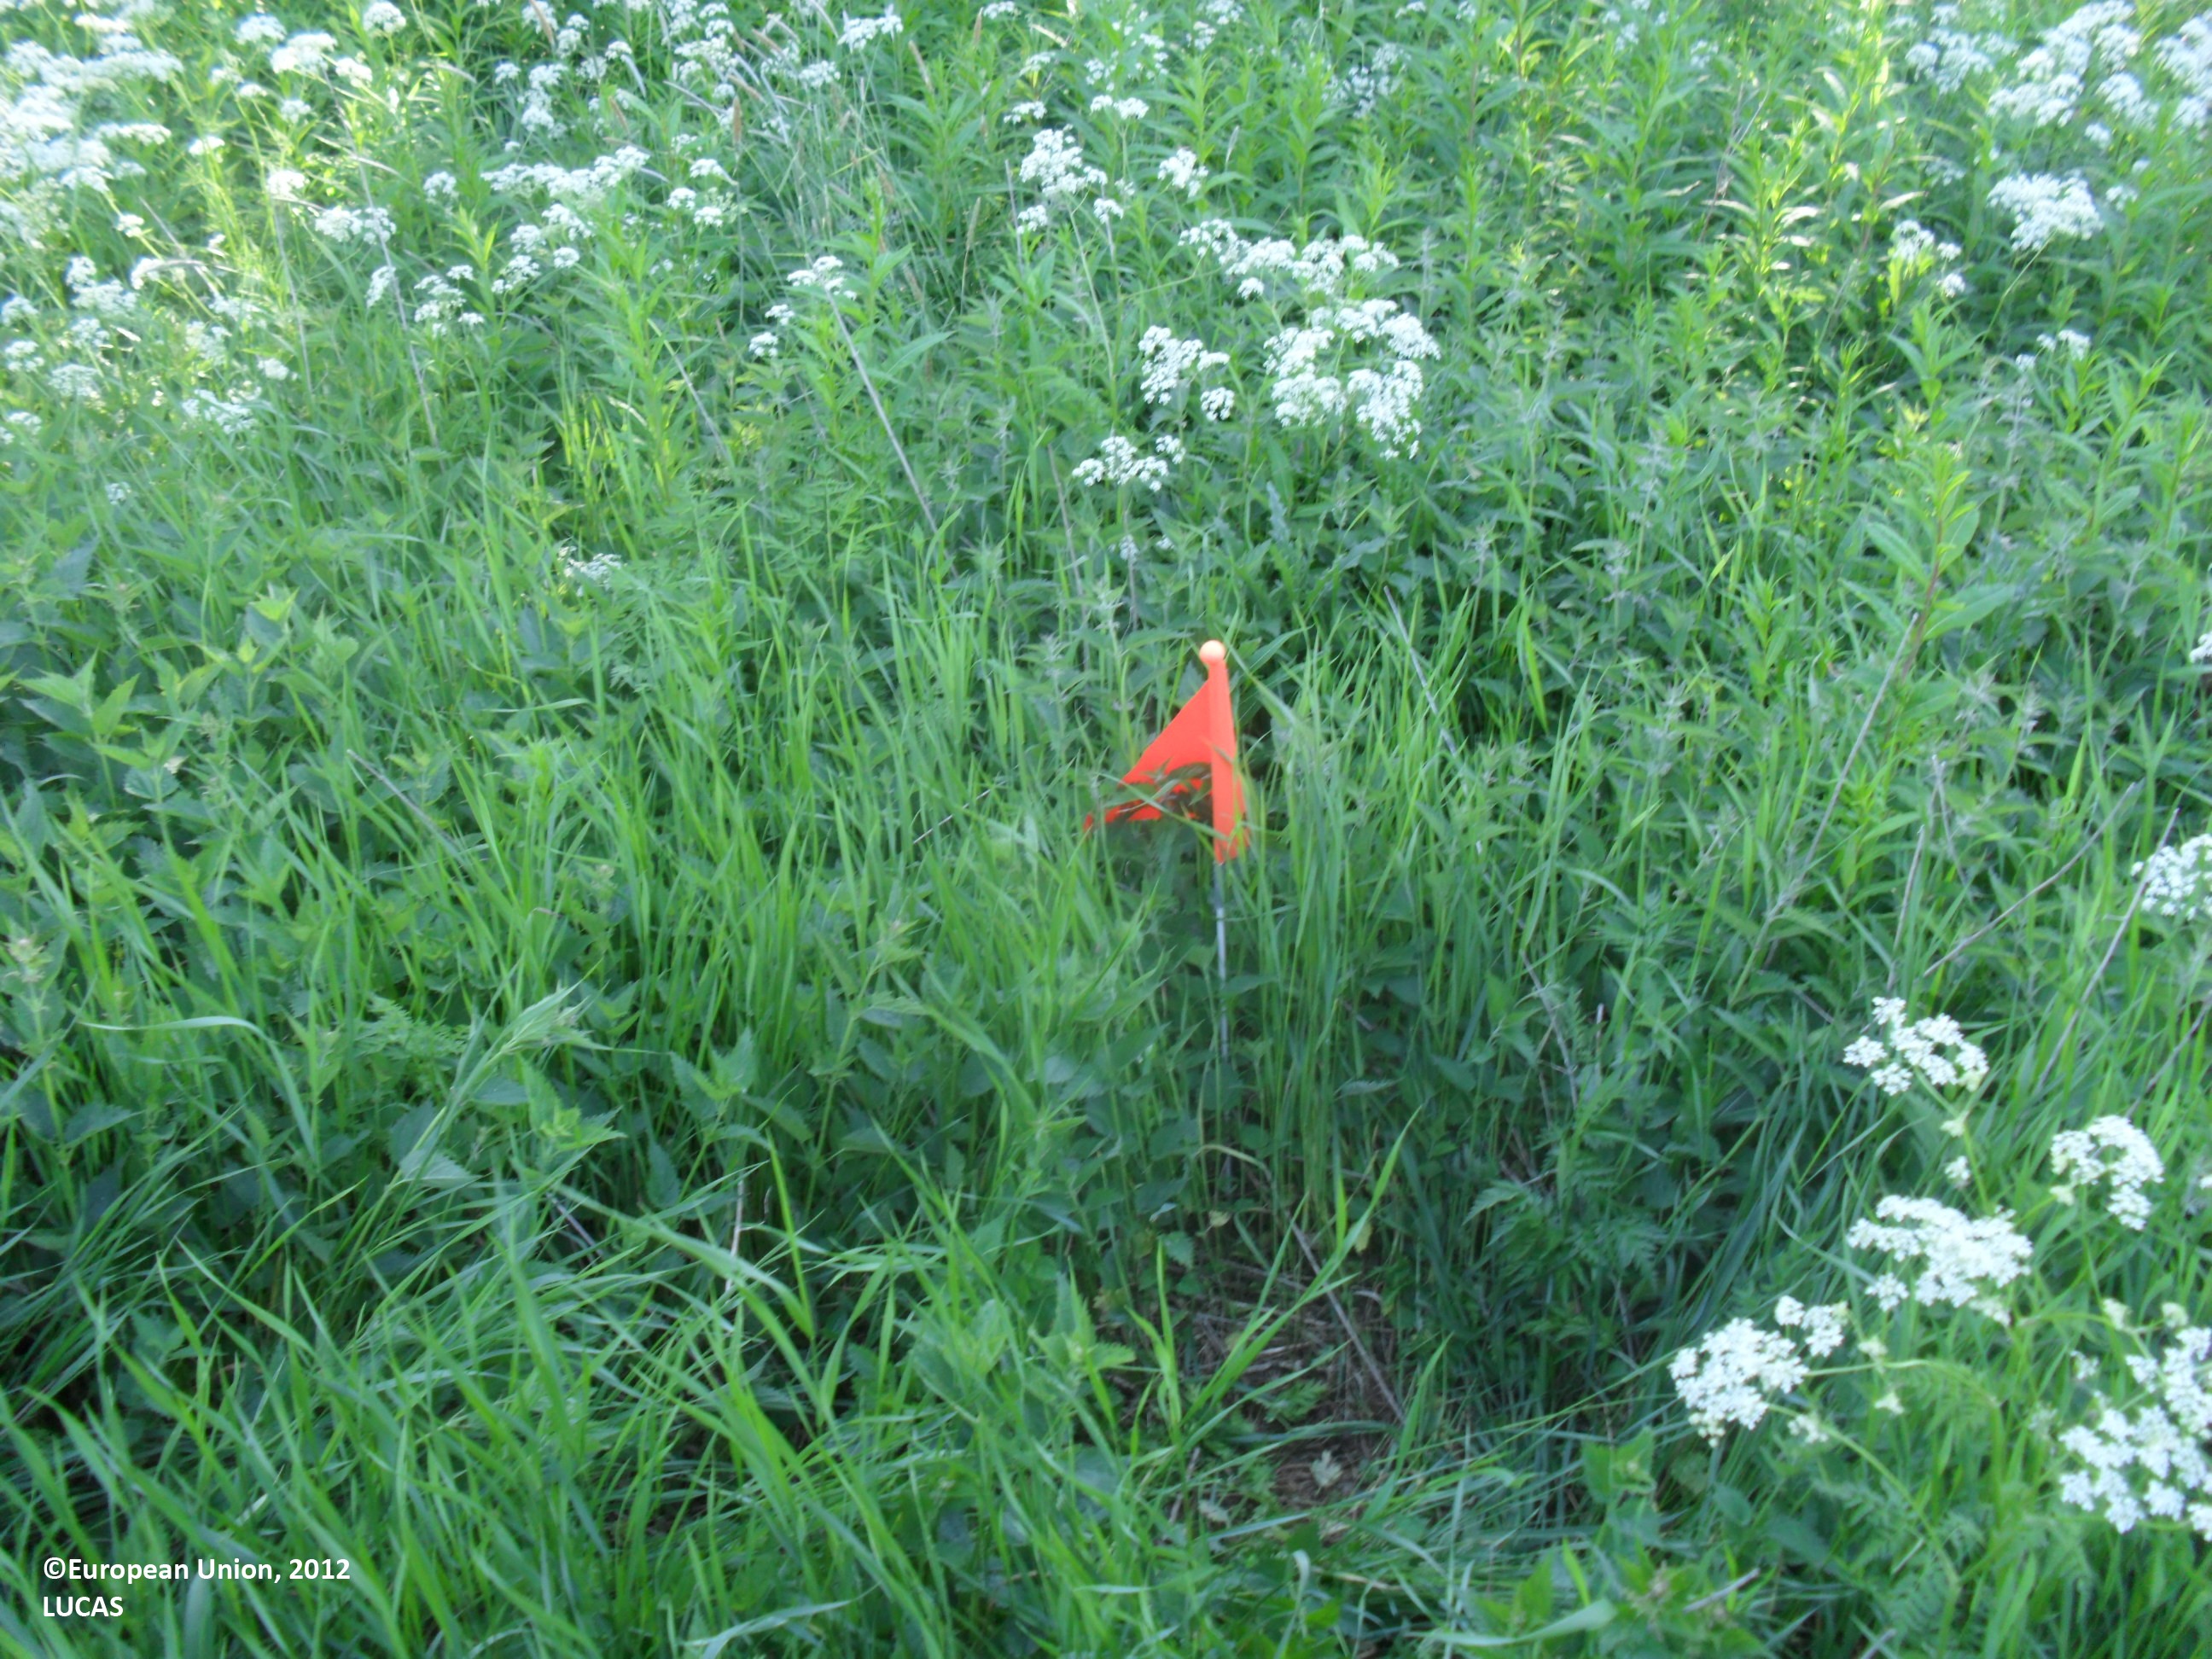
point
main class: Grassland
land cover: Spontaneously vegetated surfaces
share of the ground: > 75 %
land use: Abandoned areas
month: June
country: FI
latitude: 62.9876
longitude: 23.7475
